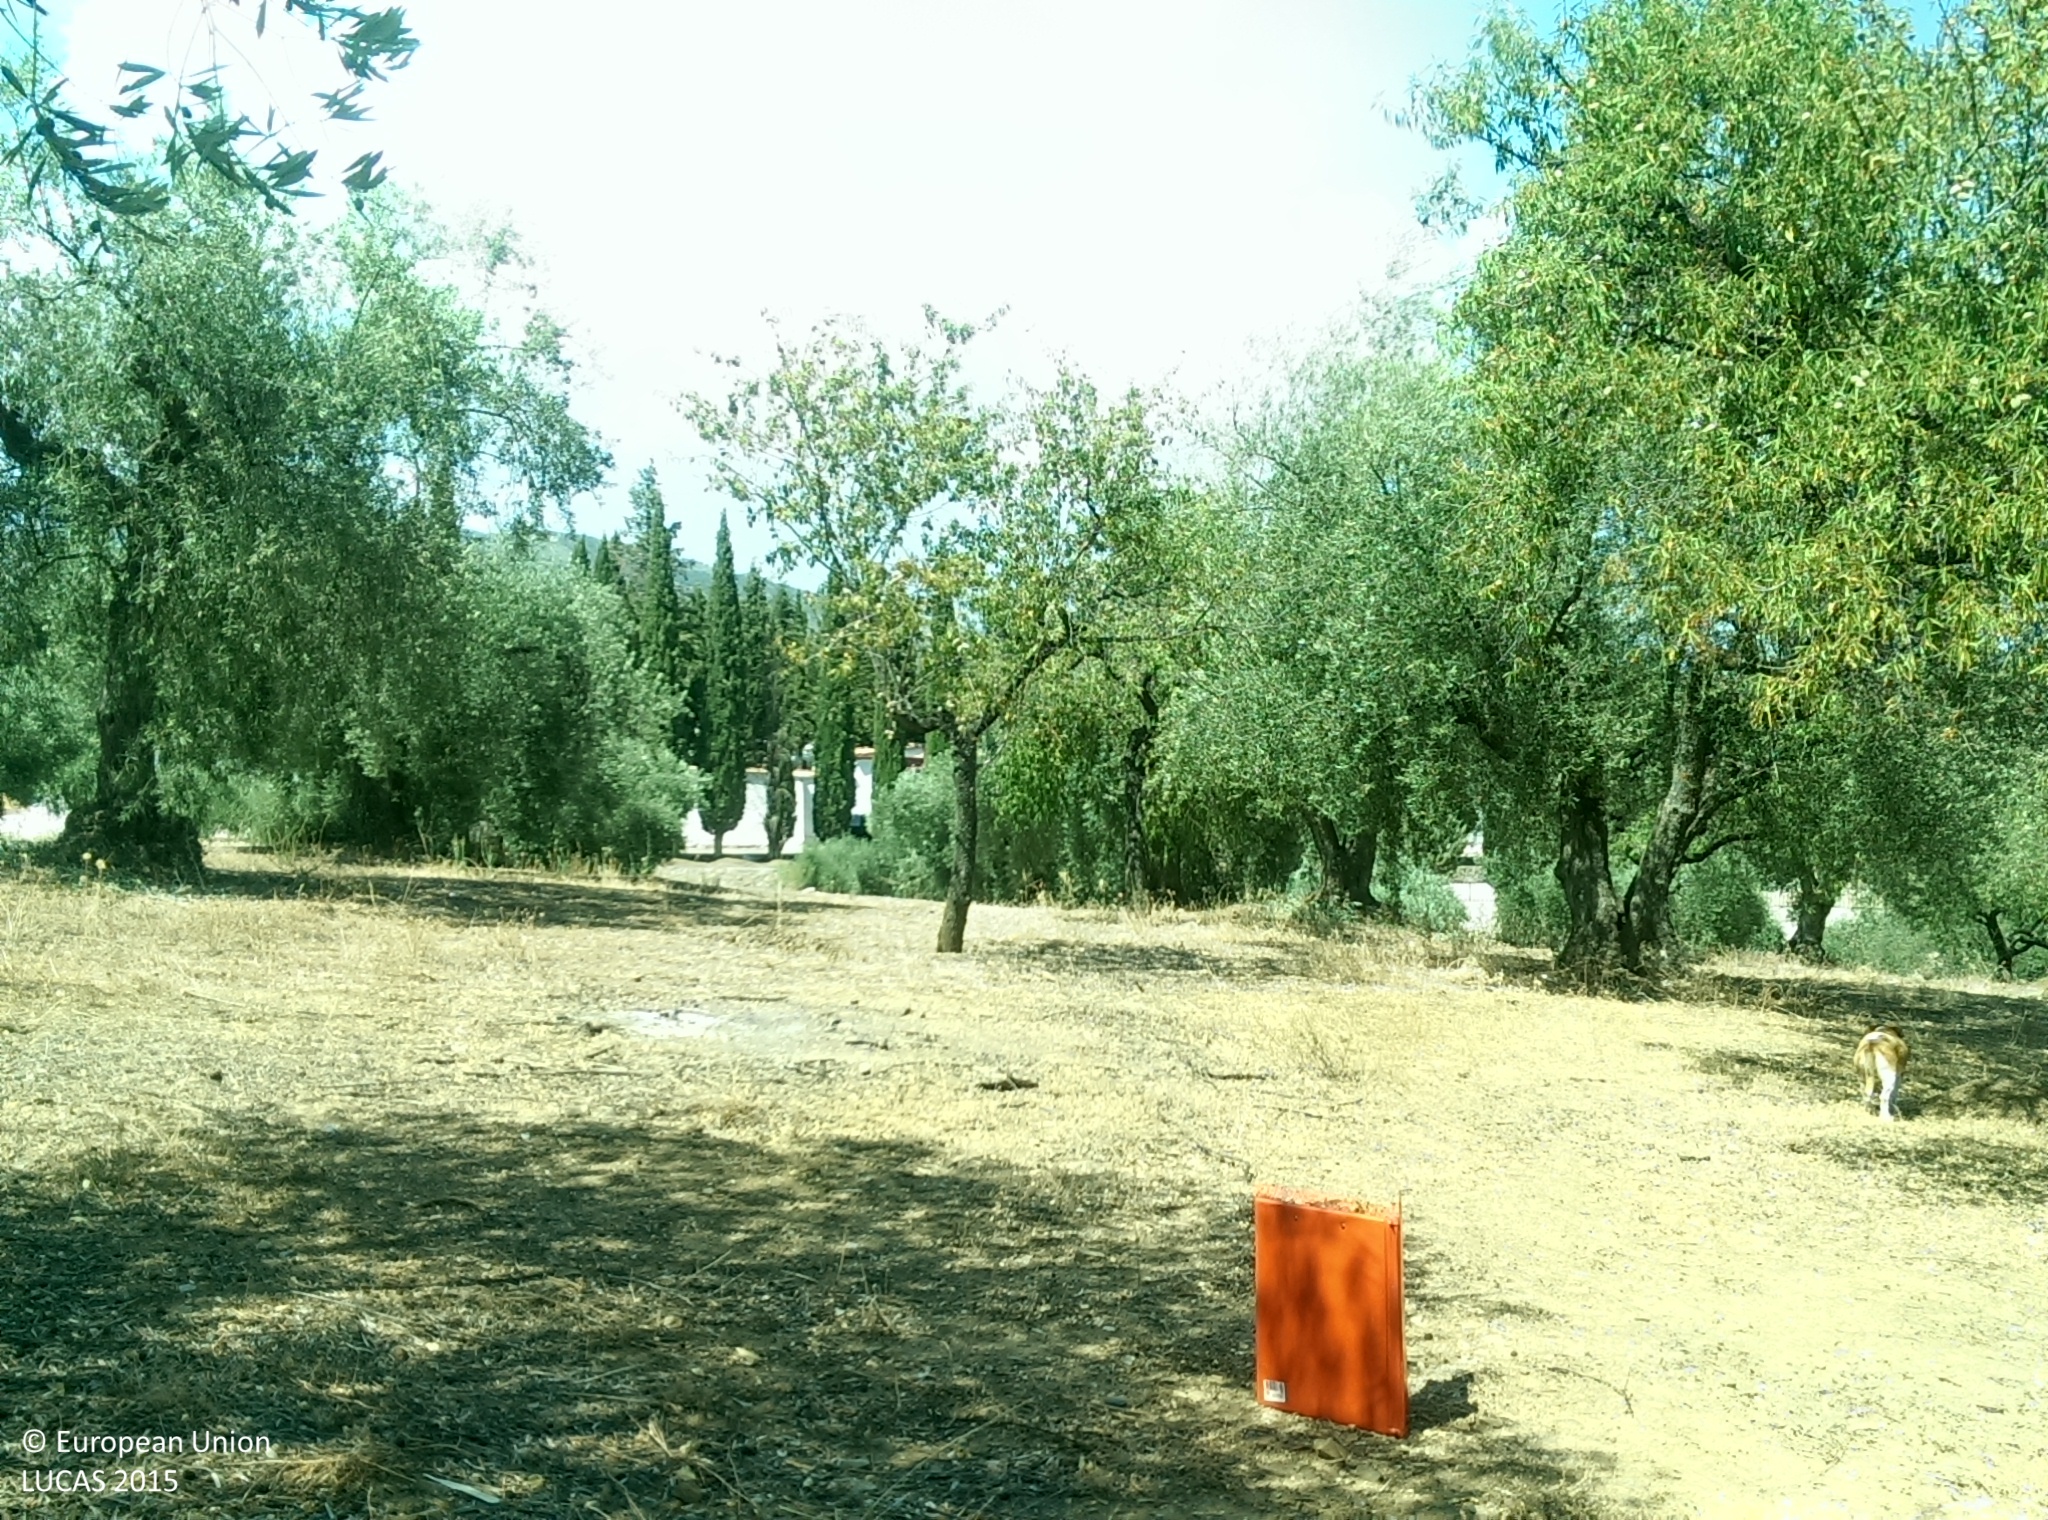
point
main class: Cropland
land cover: Olive groves
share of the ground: 10 - 25 %
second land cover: Nuts trees
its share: 10 - 25 %
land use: Agriculture (excluding fallow land and kitchen gardens)
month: July
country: ES
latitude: 36.9368
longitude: -3.1742
